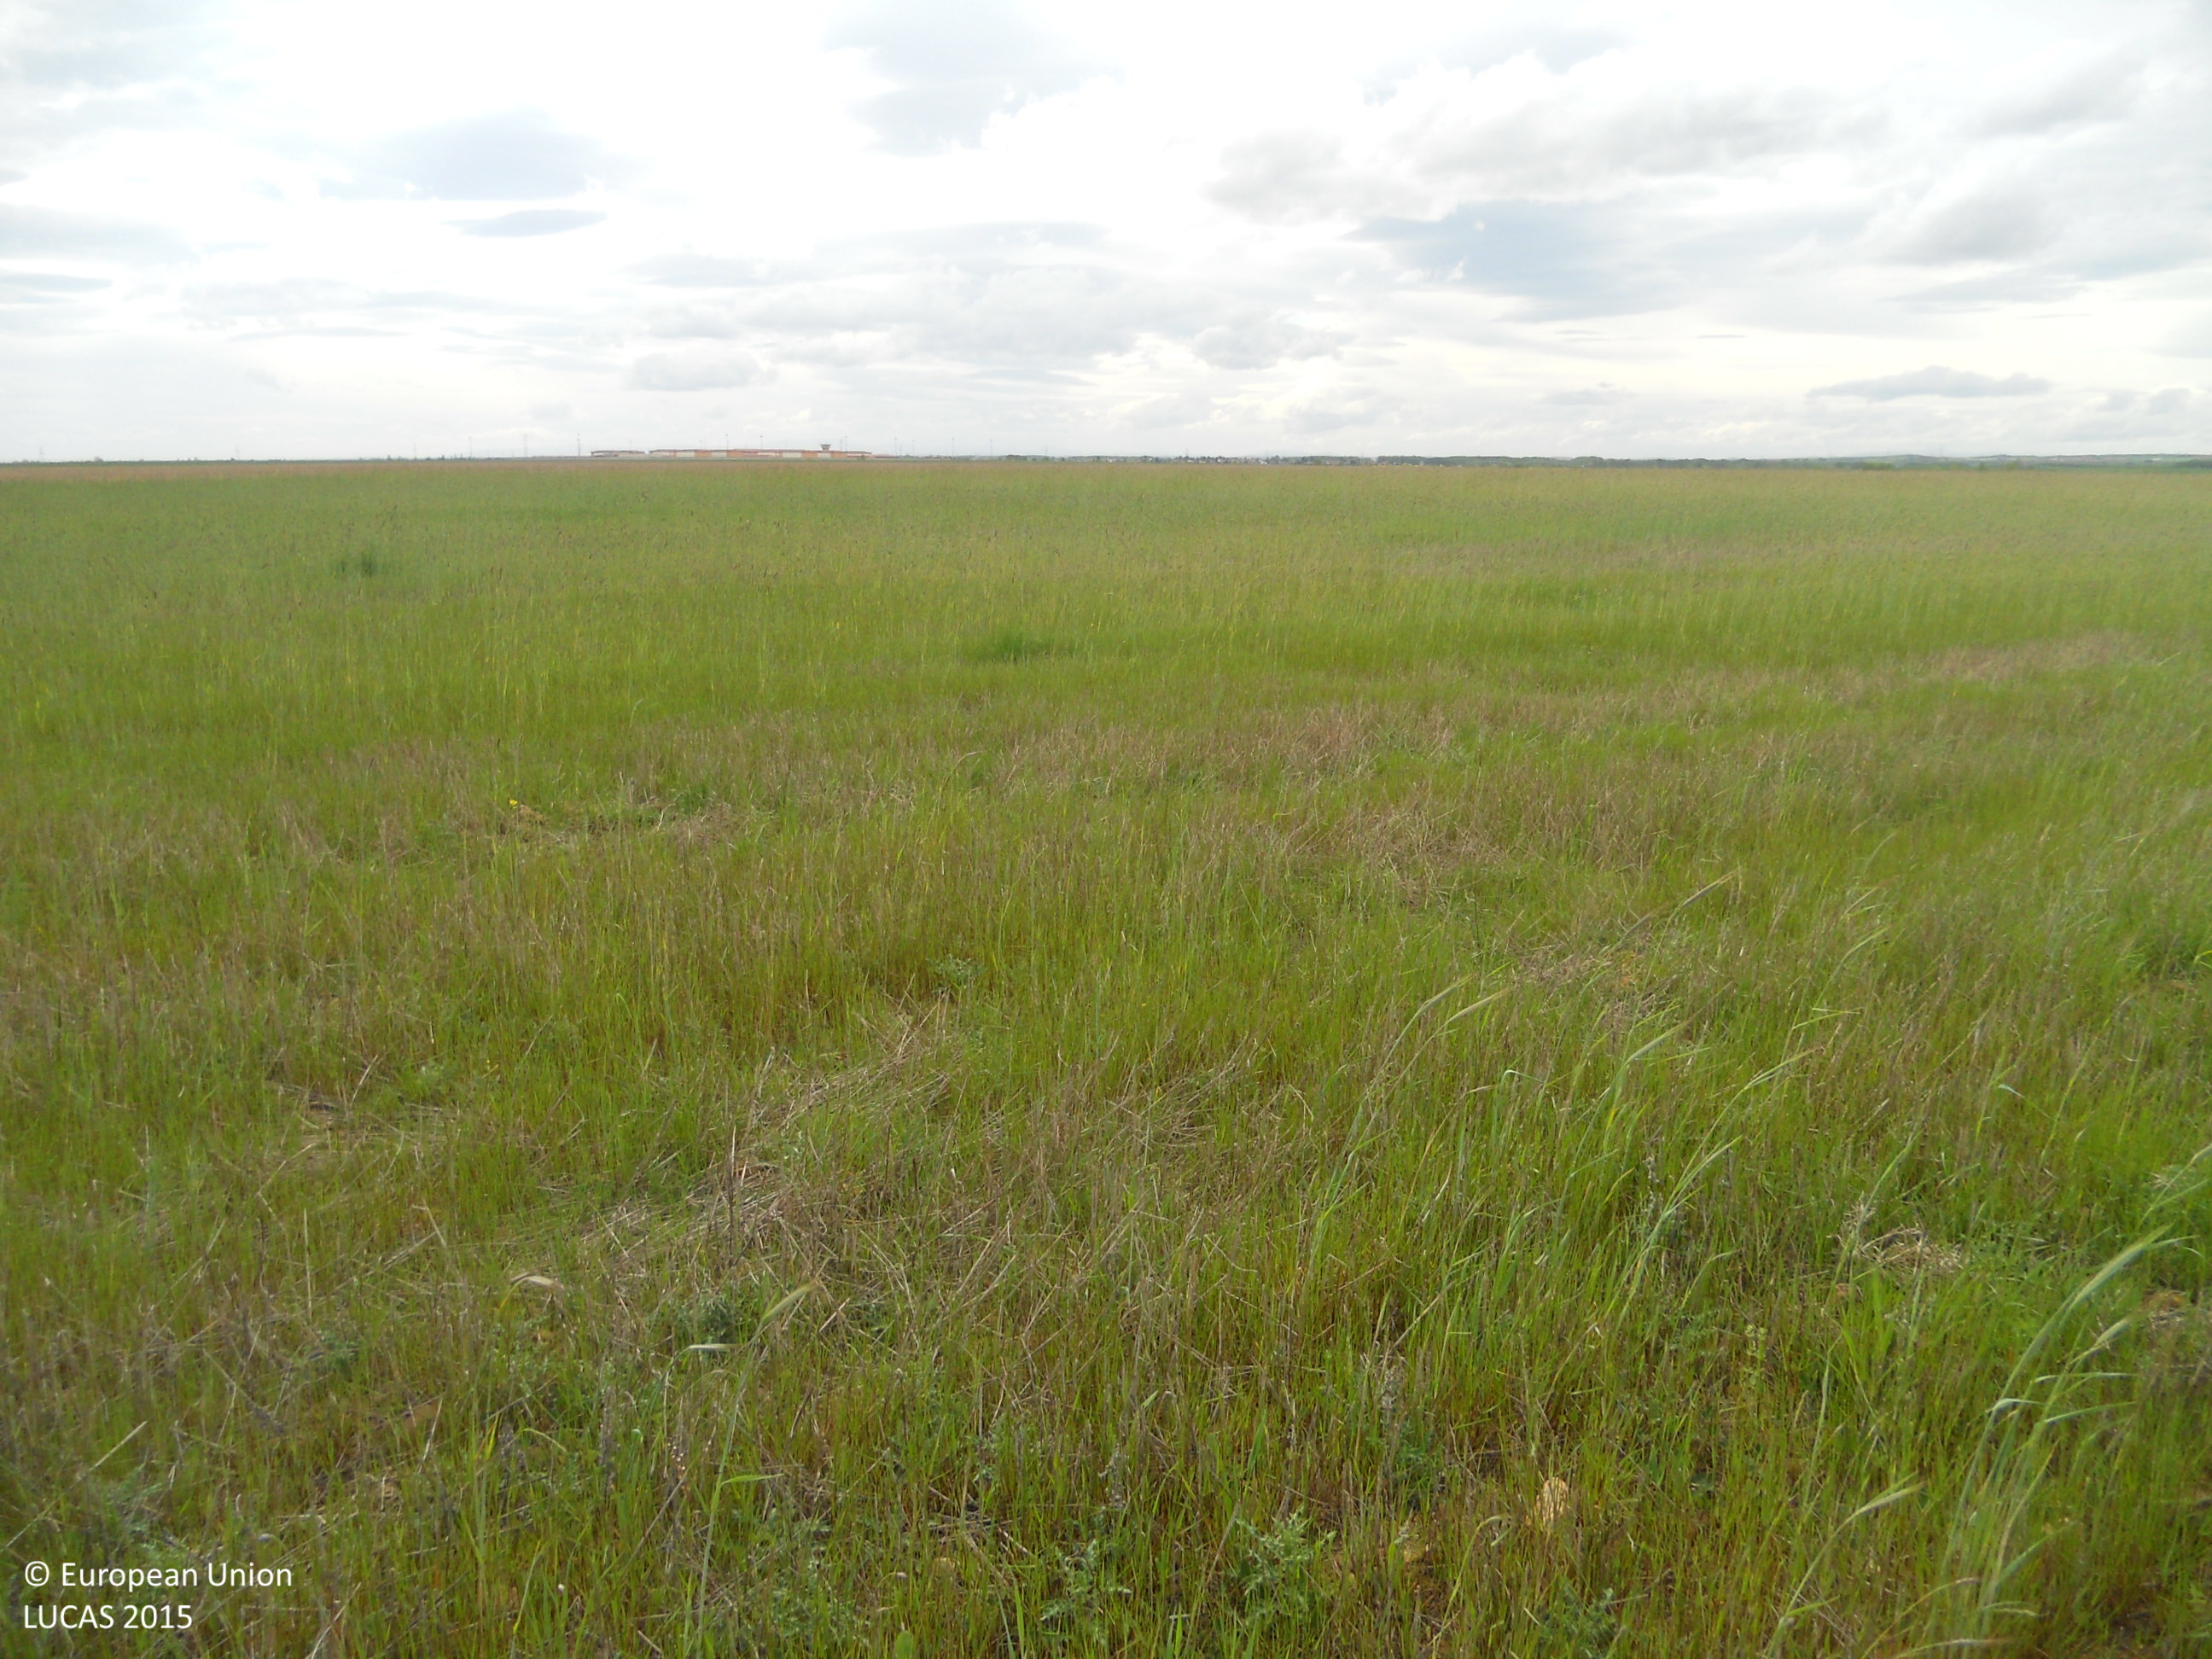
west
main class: Cropland
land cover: Rye
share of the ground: 10 - 25 %
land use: Agriculture (excluding fallow land and kitchen gardens)
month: May
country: ES
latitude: 42.5050
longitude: -5.3396
